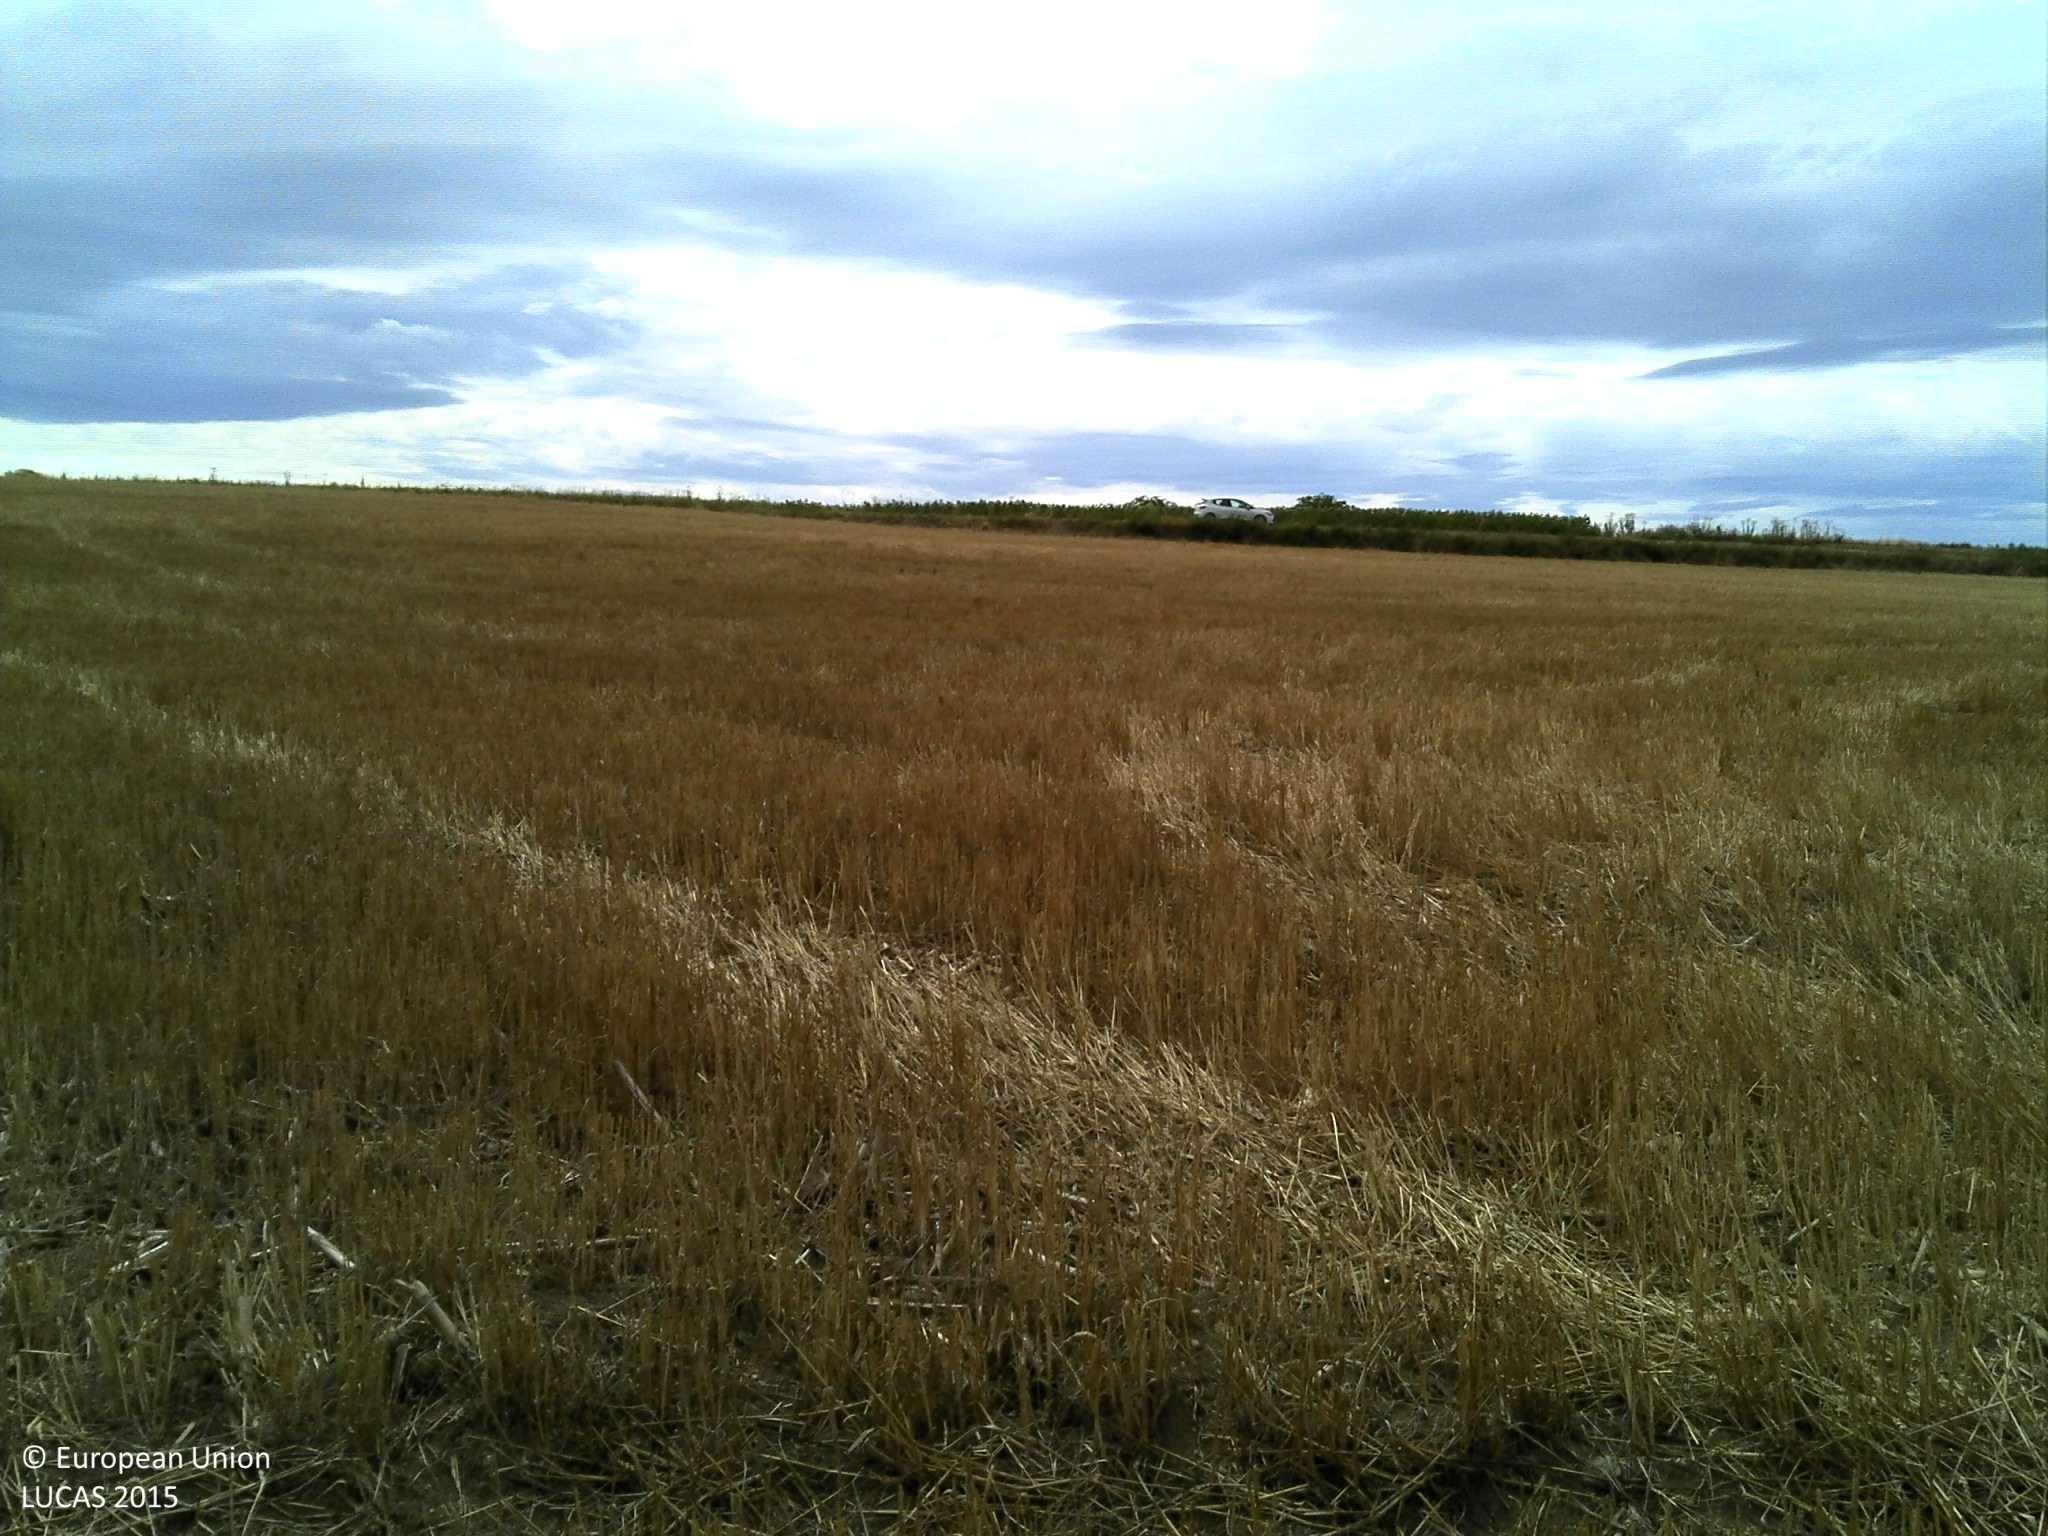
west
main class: Cropland
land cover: Common wheat
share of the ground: > 75 %
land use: Agriculture (excluding fallow land and kitchen gardens)
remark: Harvested field
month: July
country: FR
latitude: 45.7094
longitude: 3.3339
